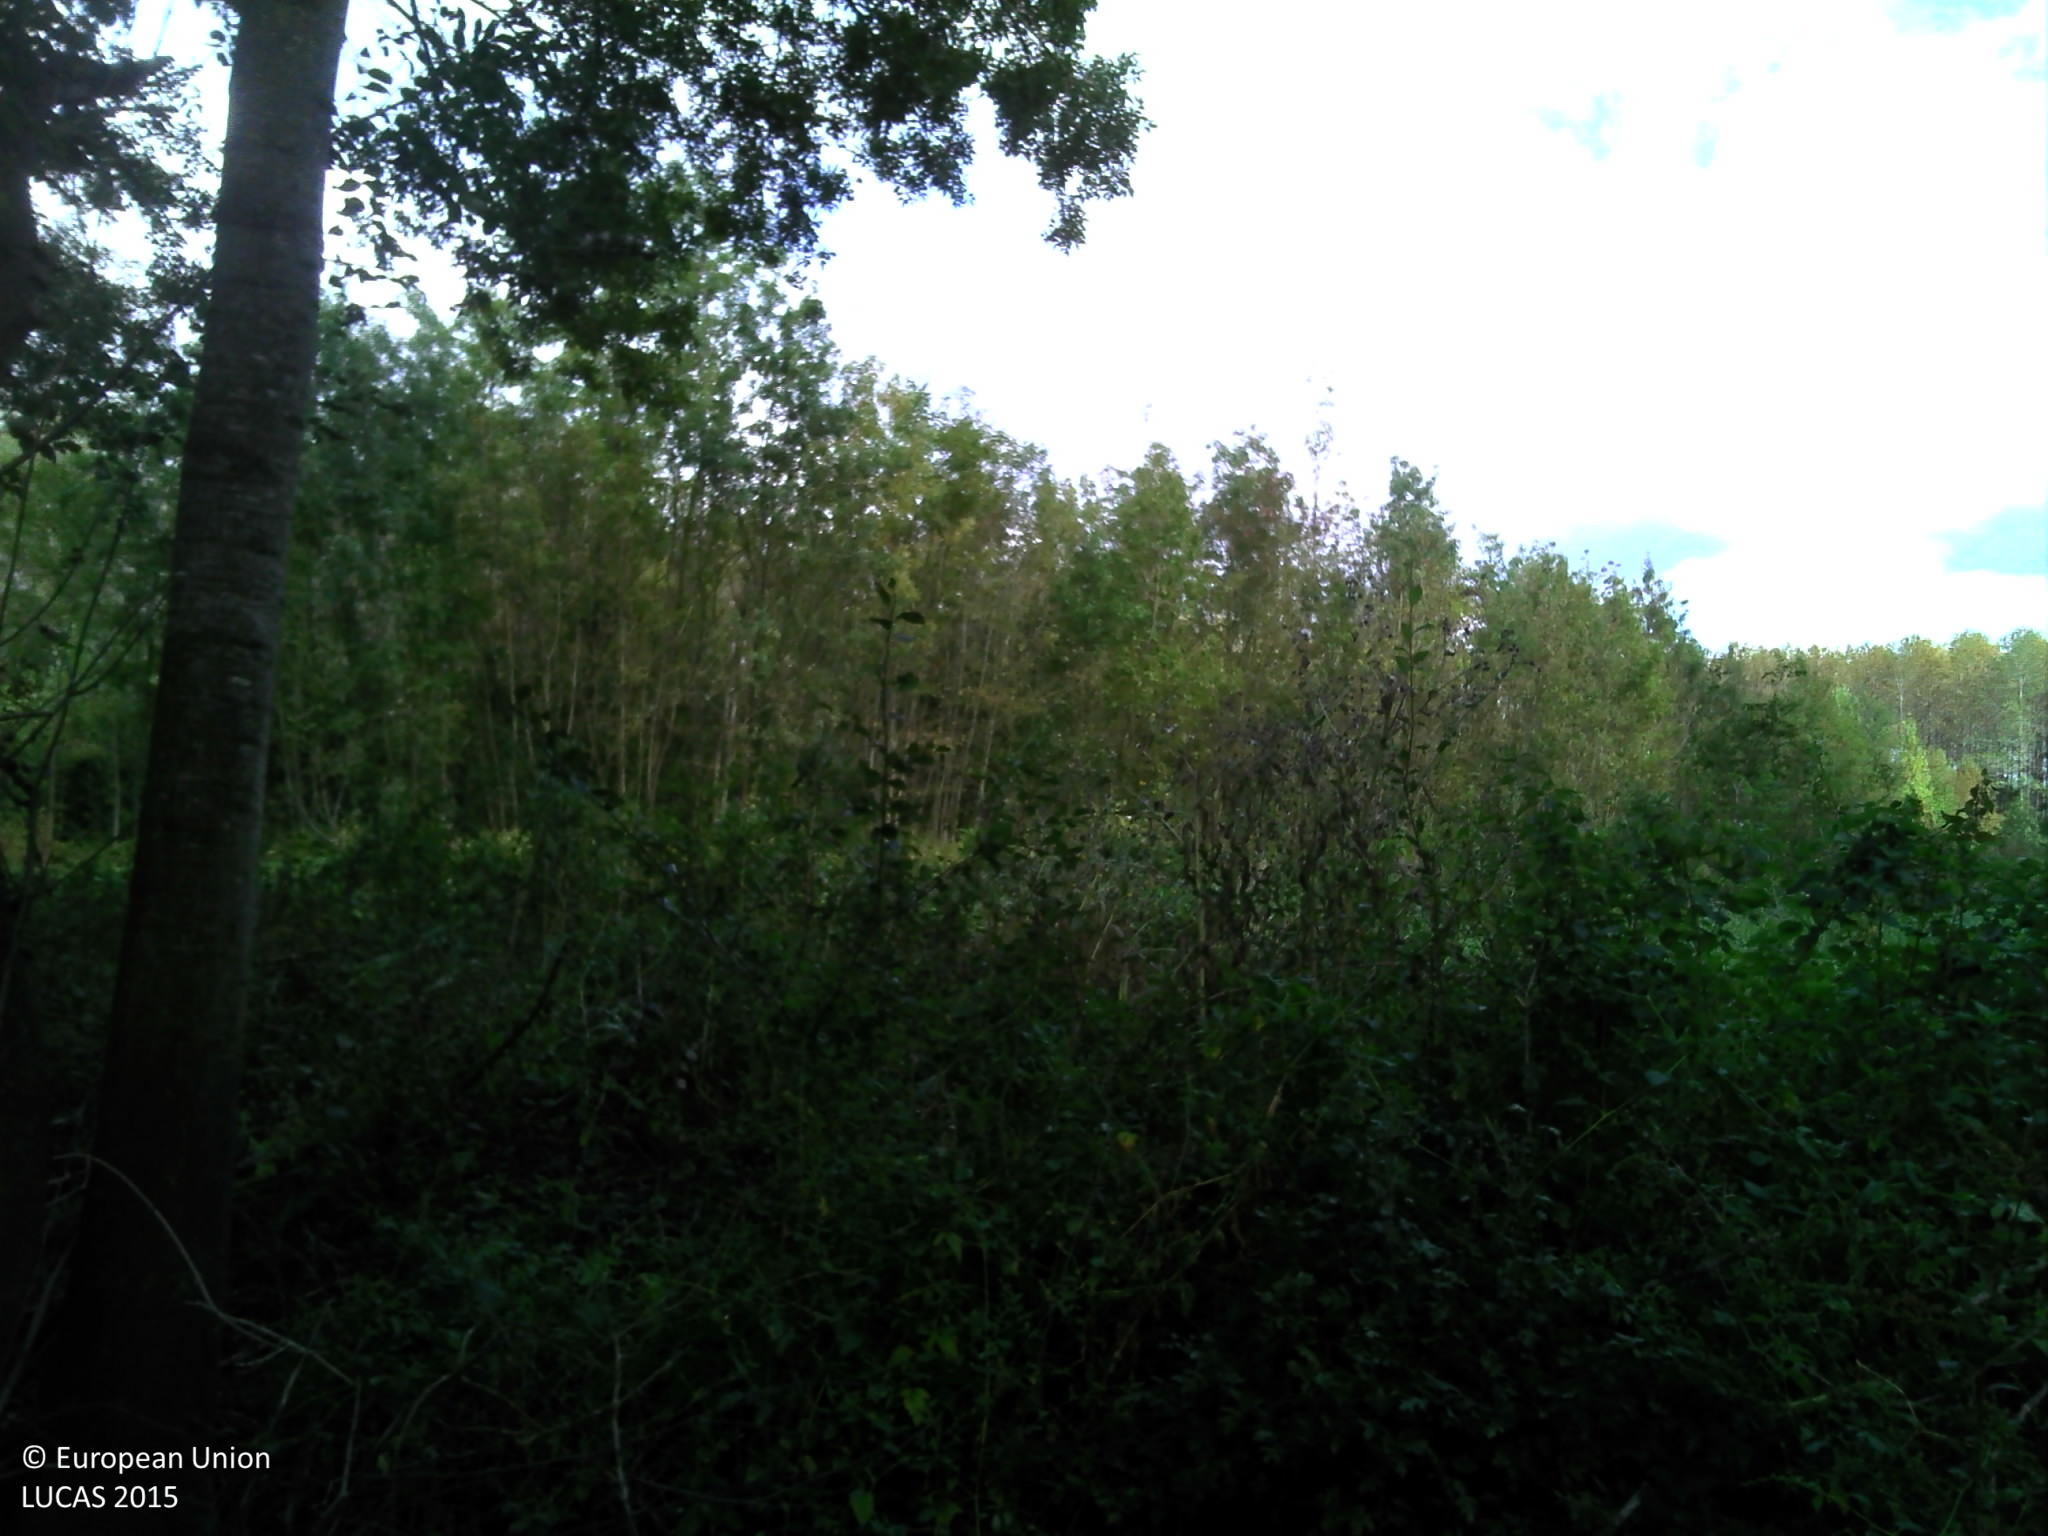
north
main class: Grassland
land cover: Grassland without tree/shrub cover
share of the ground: > 75 %
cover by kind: herbaceous plants 100 %
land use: Agriculture (excluding fallow land and kitchen gardens)
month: September
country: FR
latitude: 46.9737
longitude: 4.9930
